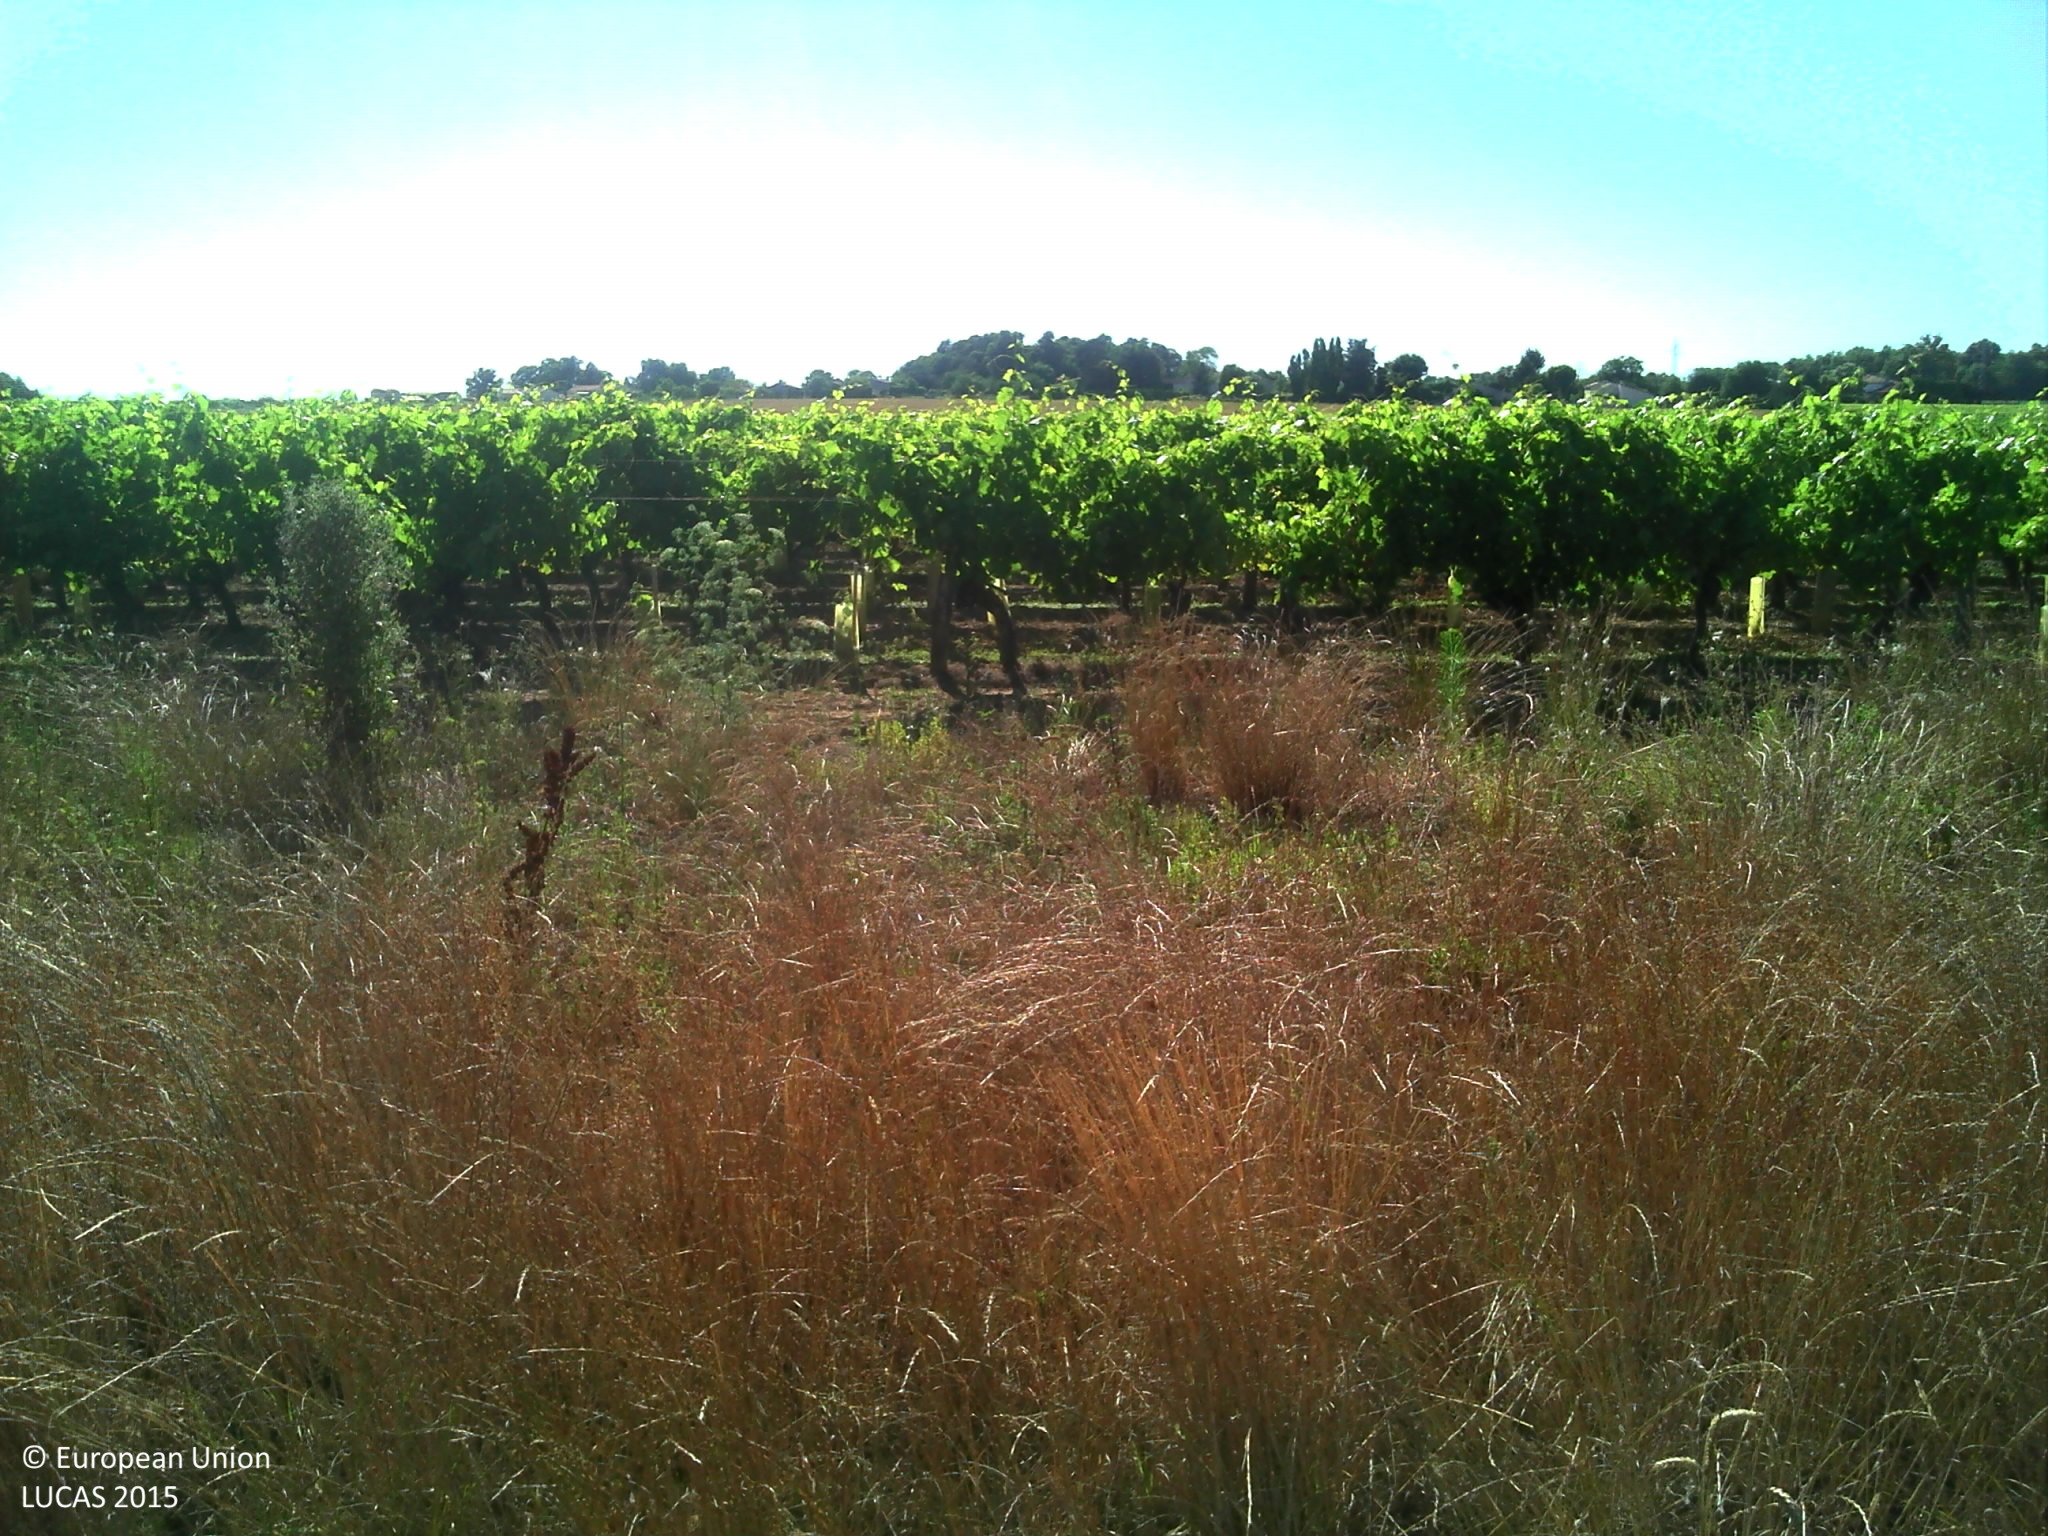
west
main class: Grassland
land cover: Spontaneously vegetated surfaces
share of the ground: > 75 %
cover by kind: herbaceous plants 100 %
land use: Agriculture (excluding fallow land and kitchen gardens)
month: June
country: FR
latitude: 45.5260
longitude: -0.6630
